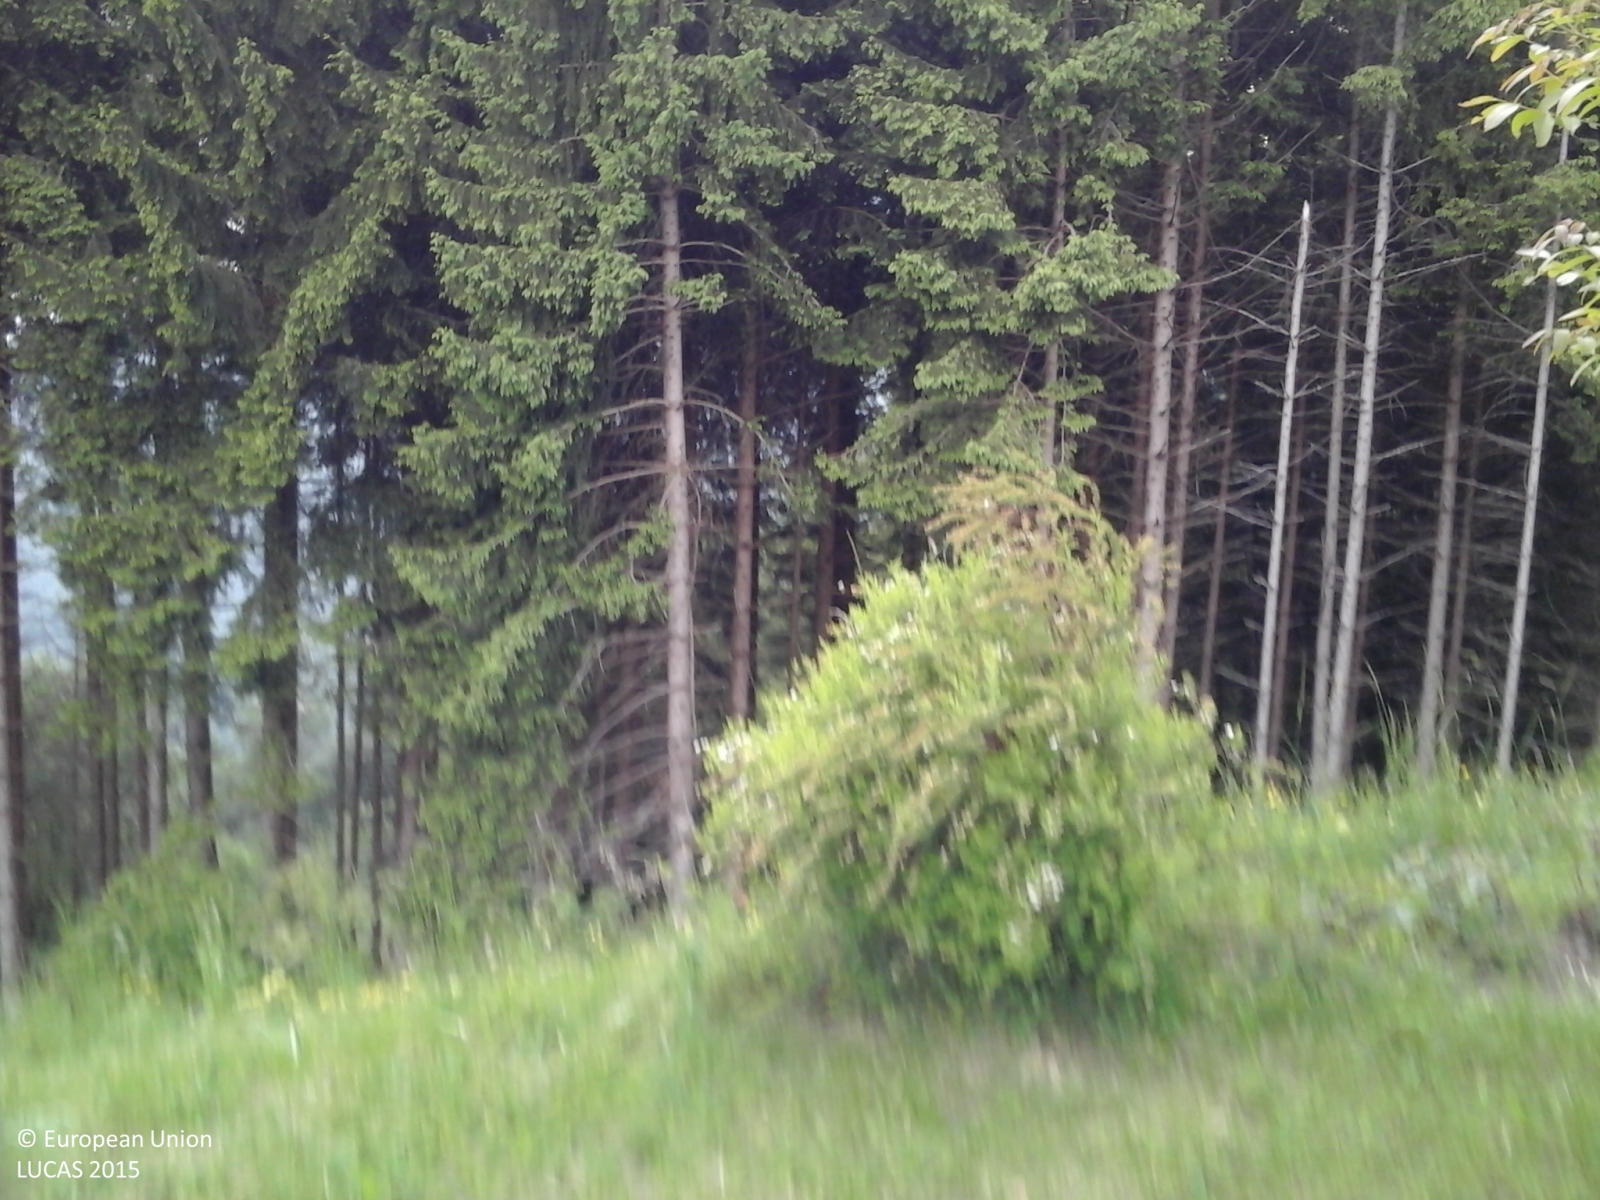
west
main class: Grassland
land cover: Grassland with sparse tree/shrub cover
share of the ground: > 75 %
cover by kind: herbaceous plants 80 %, broadleaved forest trees 5 %
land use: Residential
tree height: > 5 m
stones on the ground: < 10 %
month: May
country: IT
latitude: 46.0667
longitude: 11.7429
